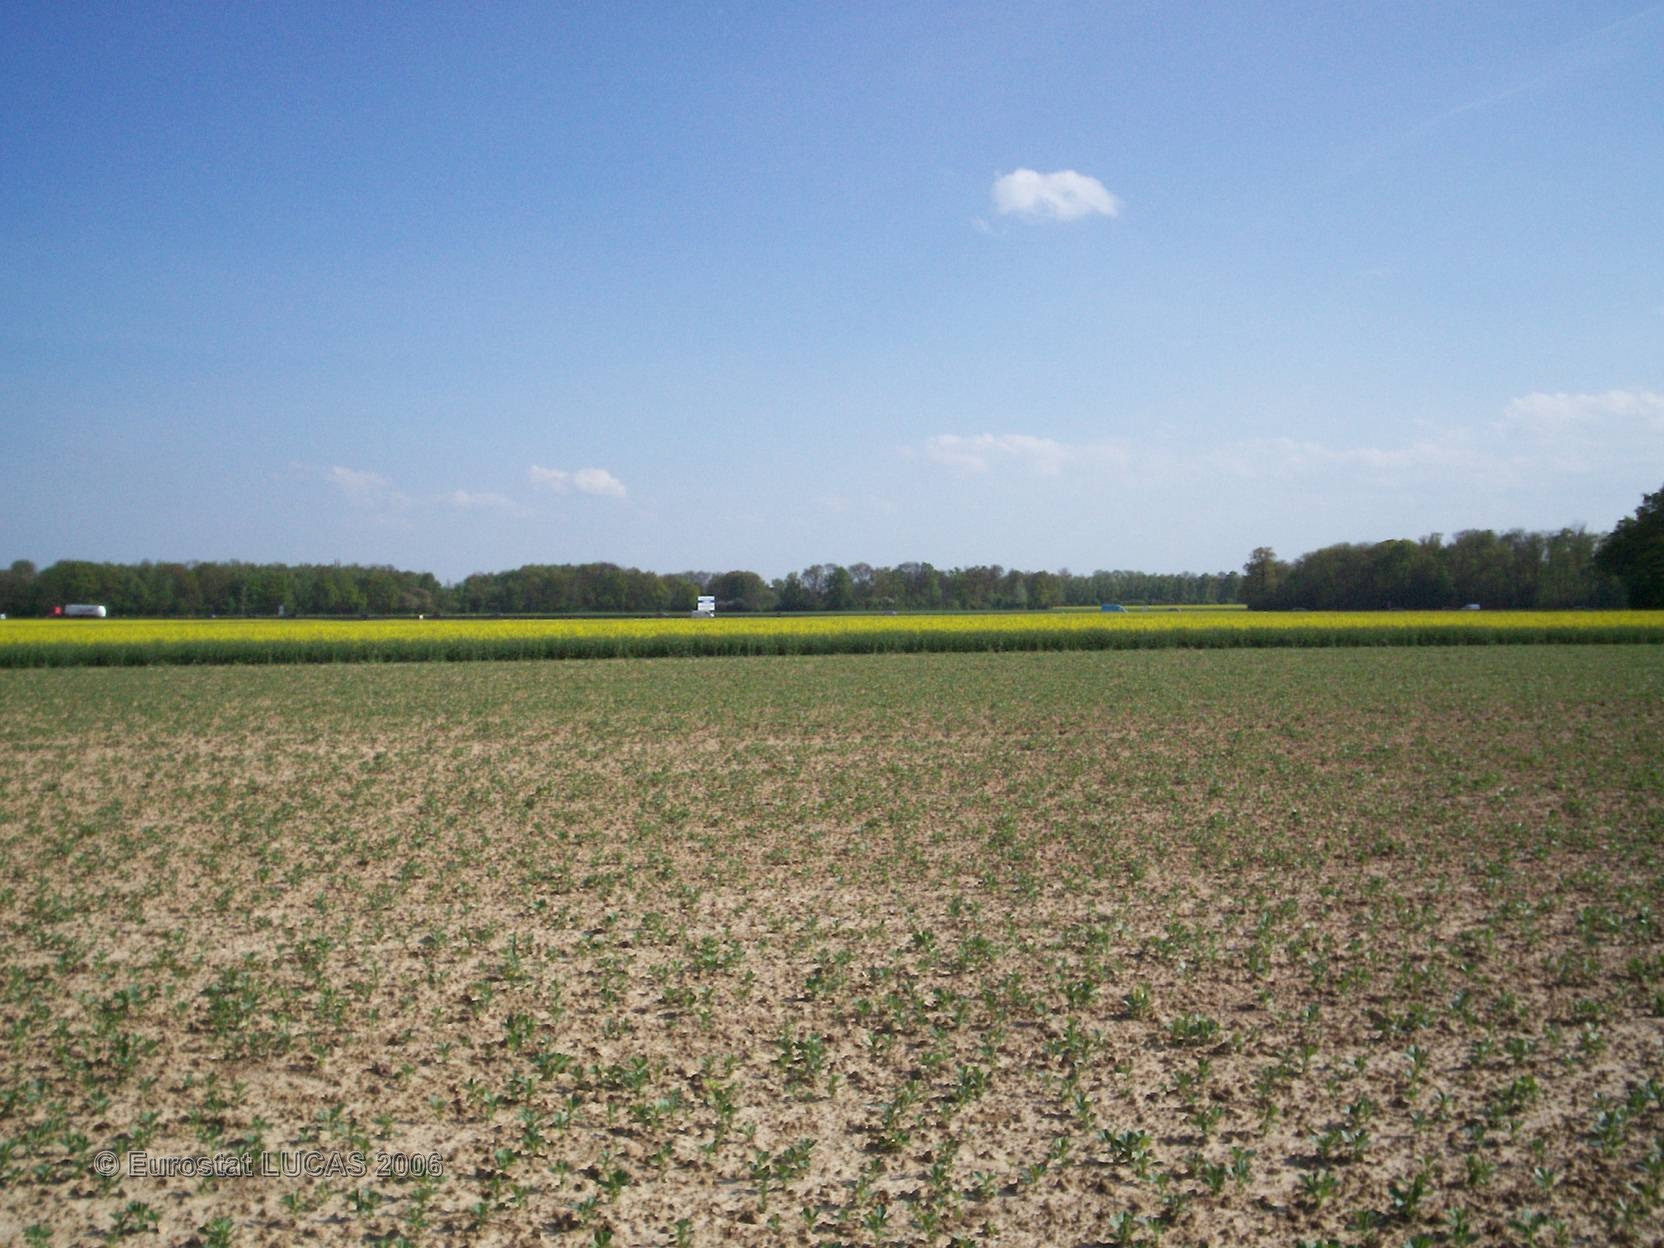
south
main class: Cropland
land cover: Sugar beet
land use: Agriculture (excluding fallow land and kitchen gardens)
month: May
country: FR
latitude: 48.8359
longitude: 2.7832
